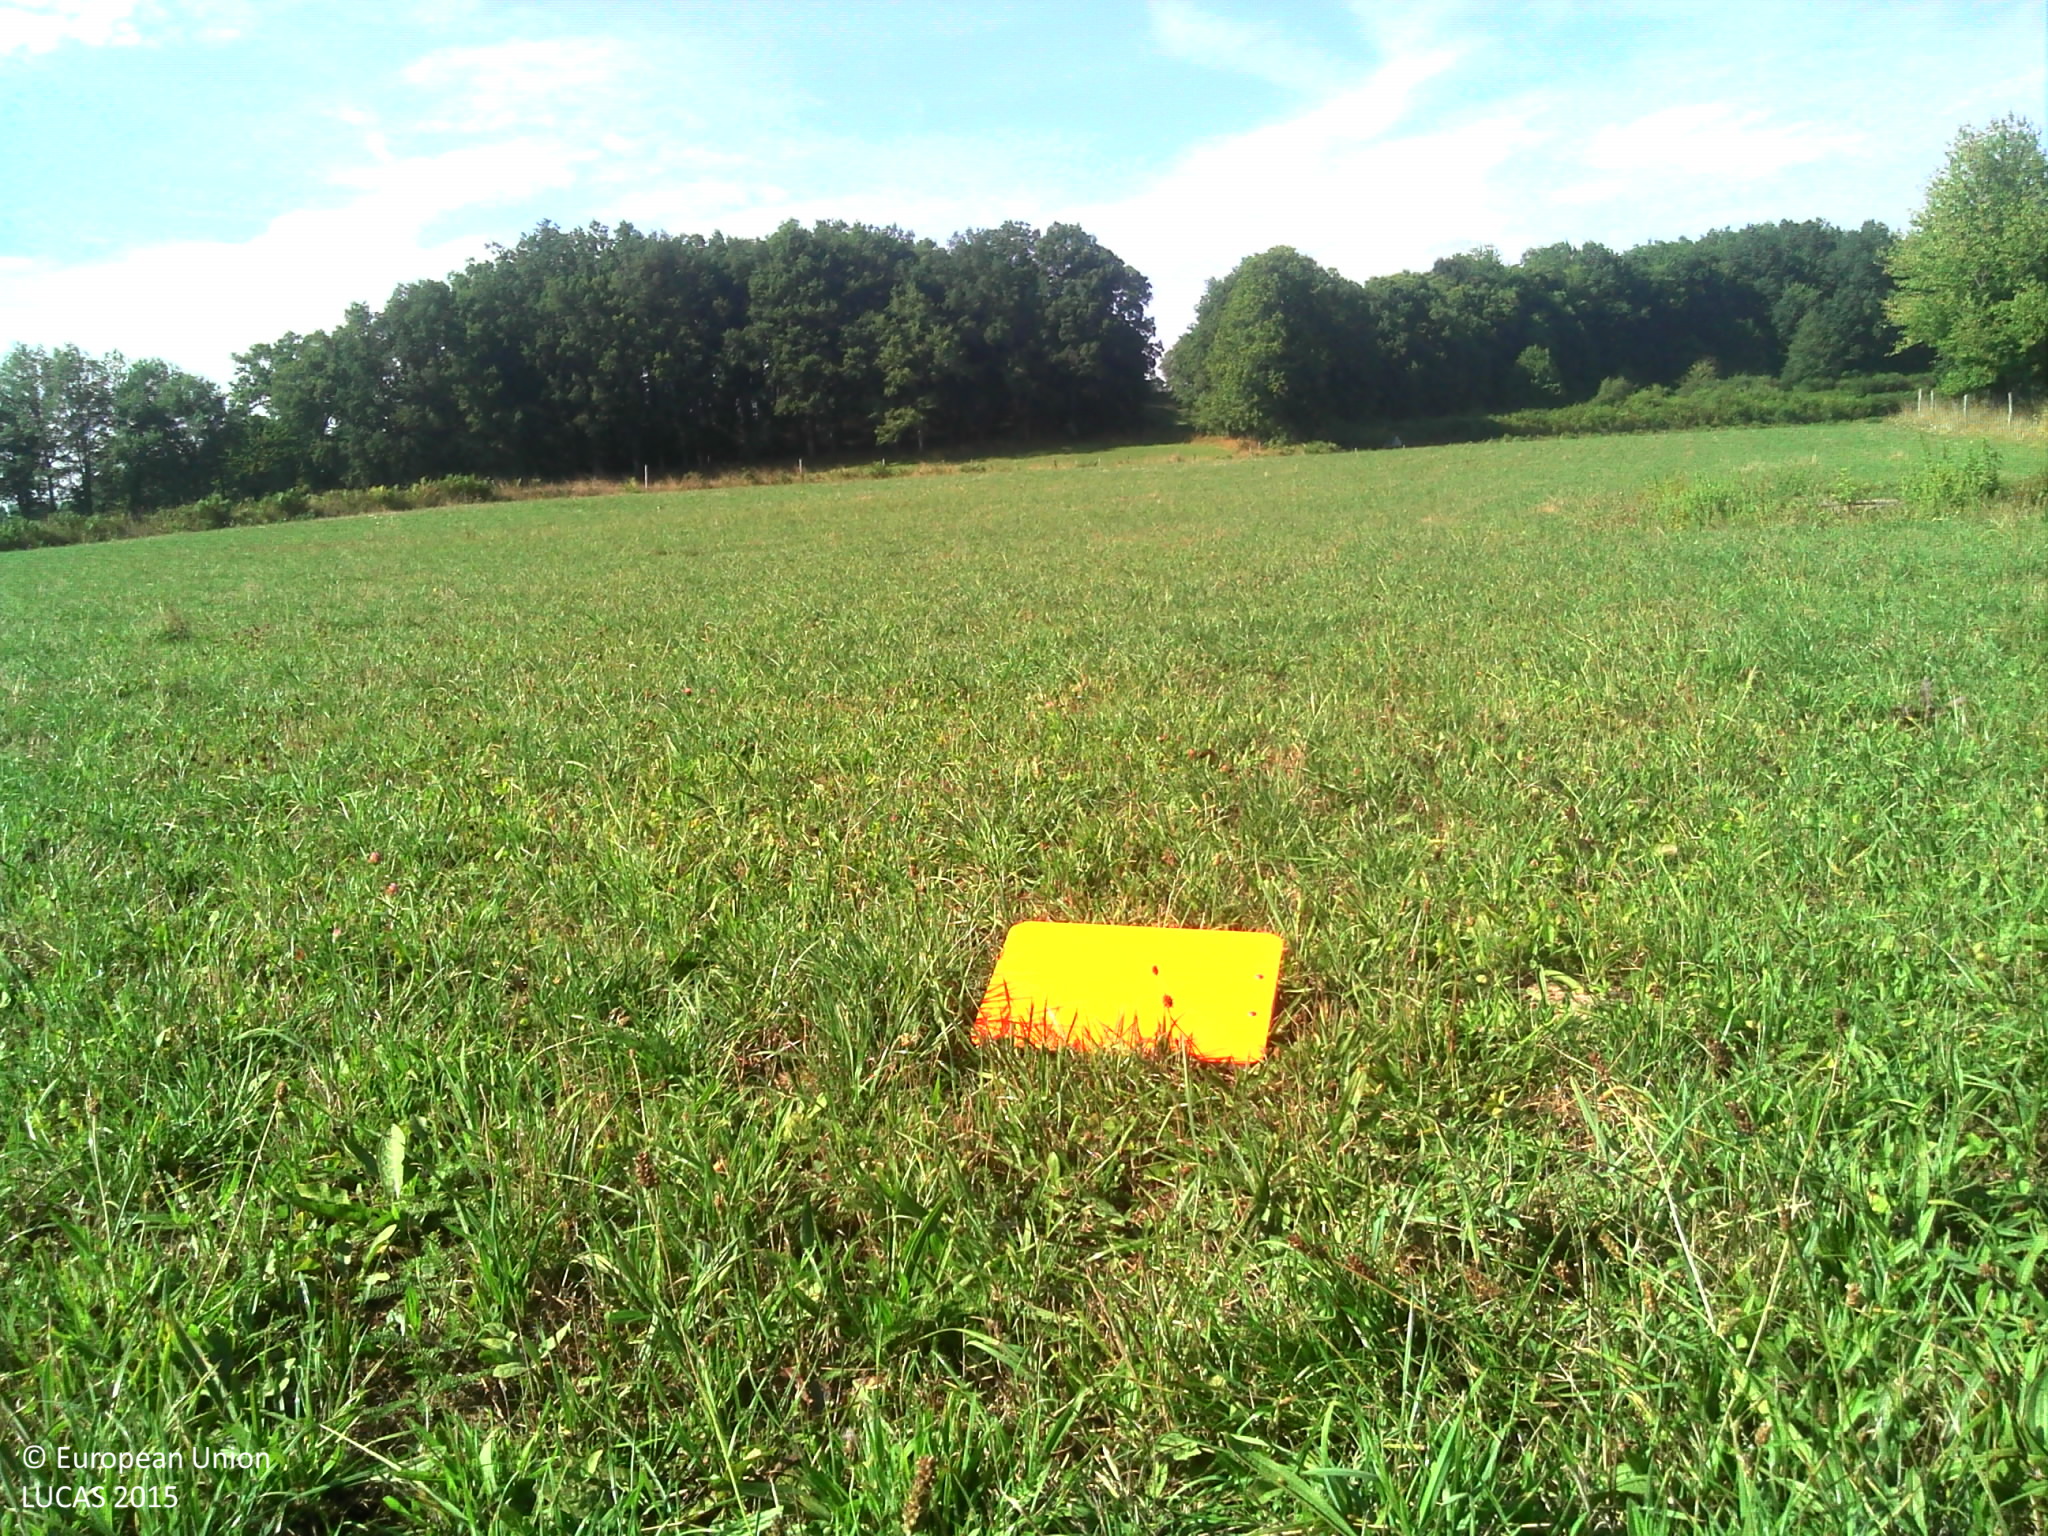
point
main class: Grassland
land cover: Grassland without tree/shrub cover
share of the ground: > 75 %
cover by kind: herbaceous plants 100 %
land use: Agriculture (excluding fallow land and kitchen gardens)
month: August
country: FR
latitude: 46.1424
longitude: 1.7721
